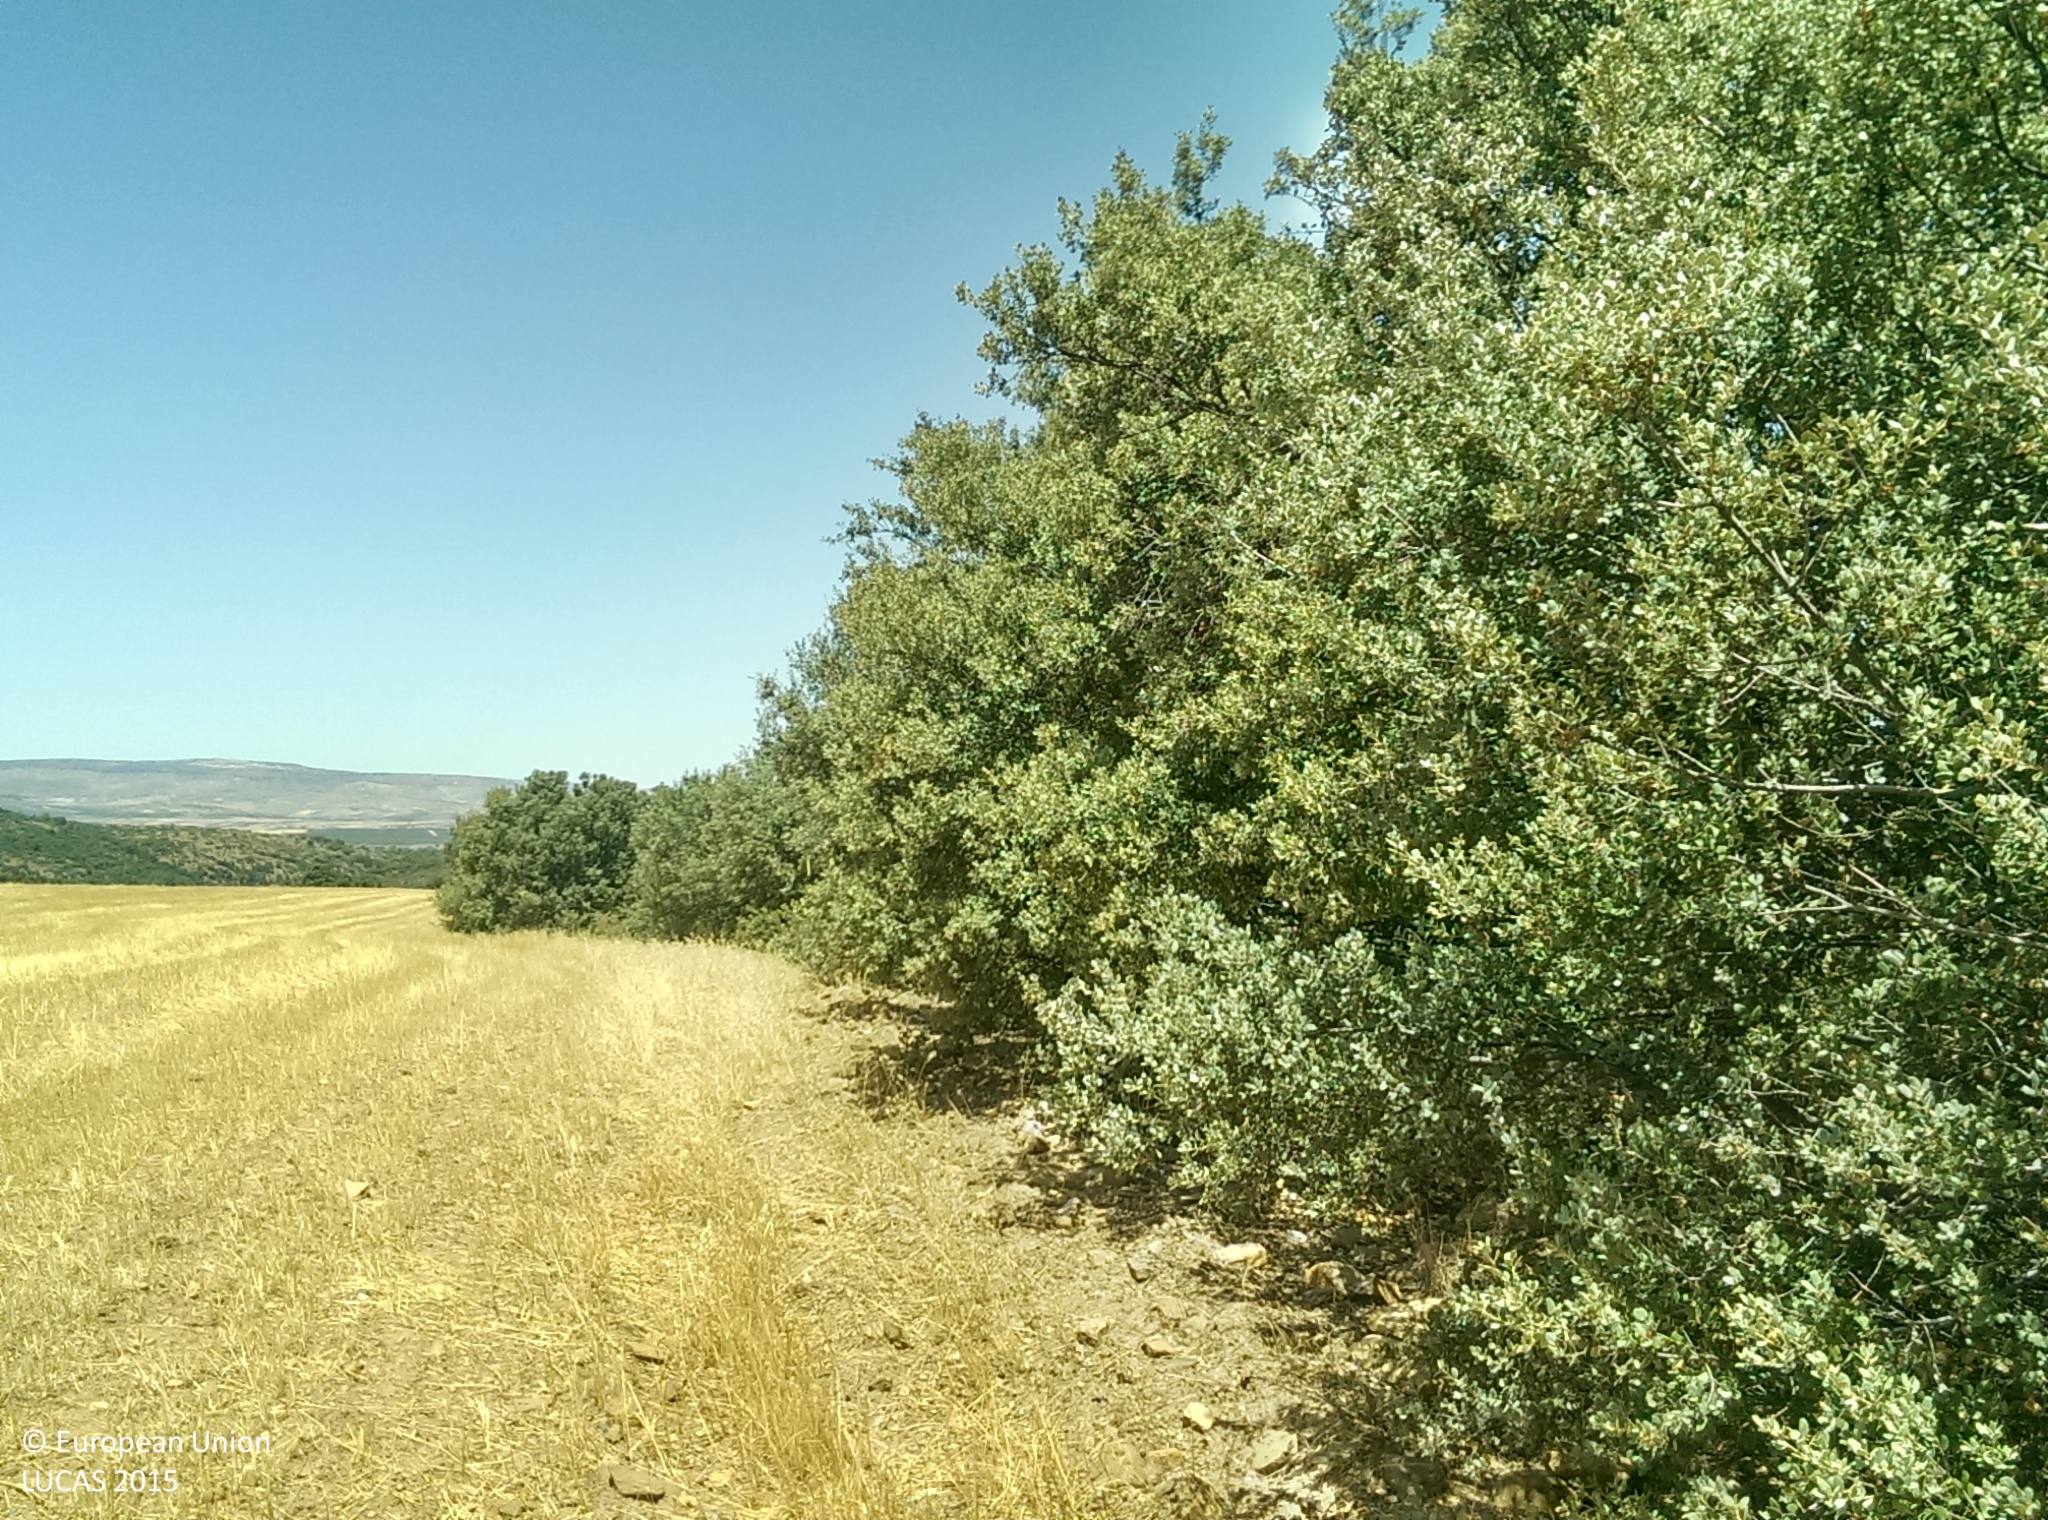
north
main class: Cropland
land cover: Oats
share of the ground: < 10 %
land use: Agriculture (excluding fallow land and kitchen gardens)
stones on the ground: 25 - 50 %
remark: Harvested field
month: July
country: ES
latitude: 37.2374
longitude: -3.2544
